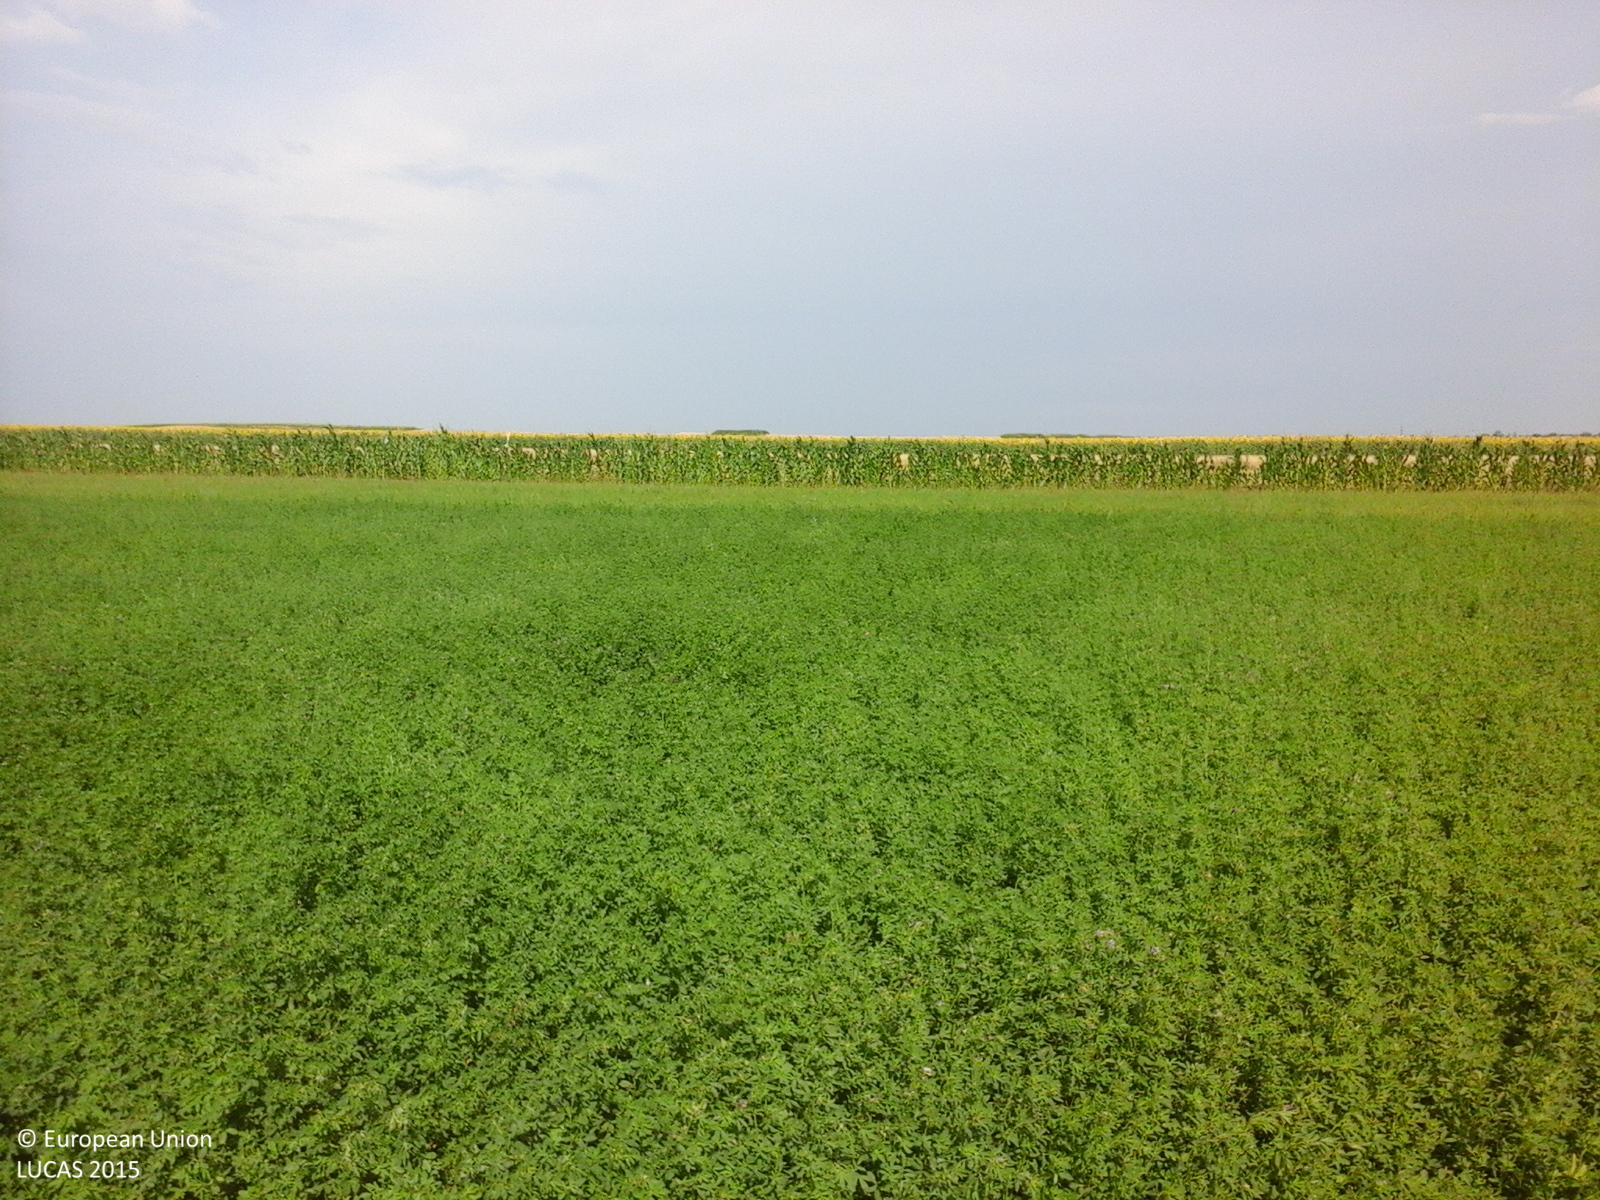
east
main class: Cropland
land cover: Lucerne
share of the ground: > 75 %
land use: Agriculture (excluding fallow land and kitchen gardens)
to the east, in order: Lucerne; Maize; Common wheat; Lucerne; Other fresh vegetables; Sunflower; Common wheat
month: July
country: RO
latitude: 43.7700
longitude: 24.3353
